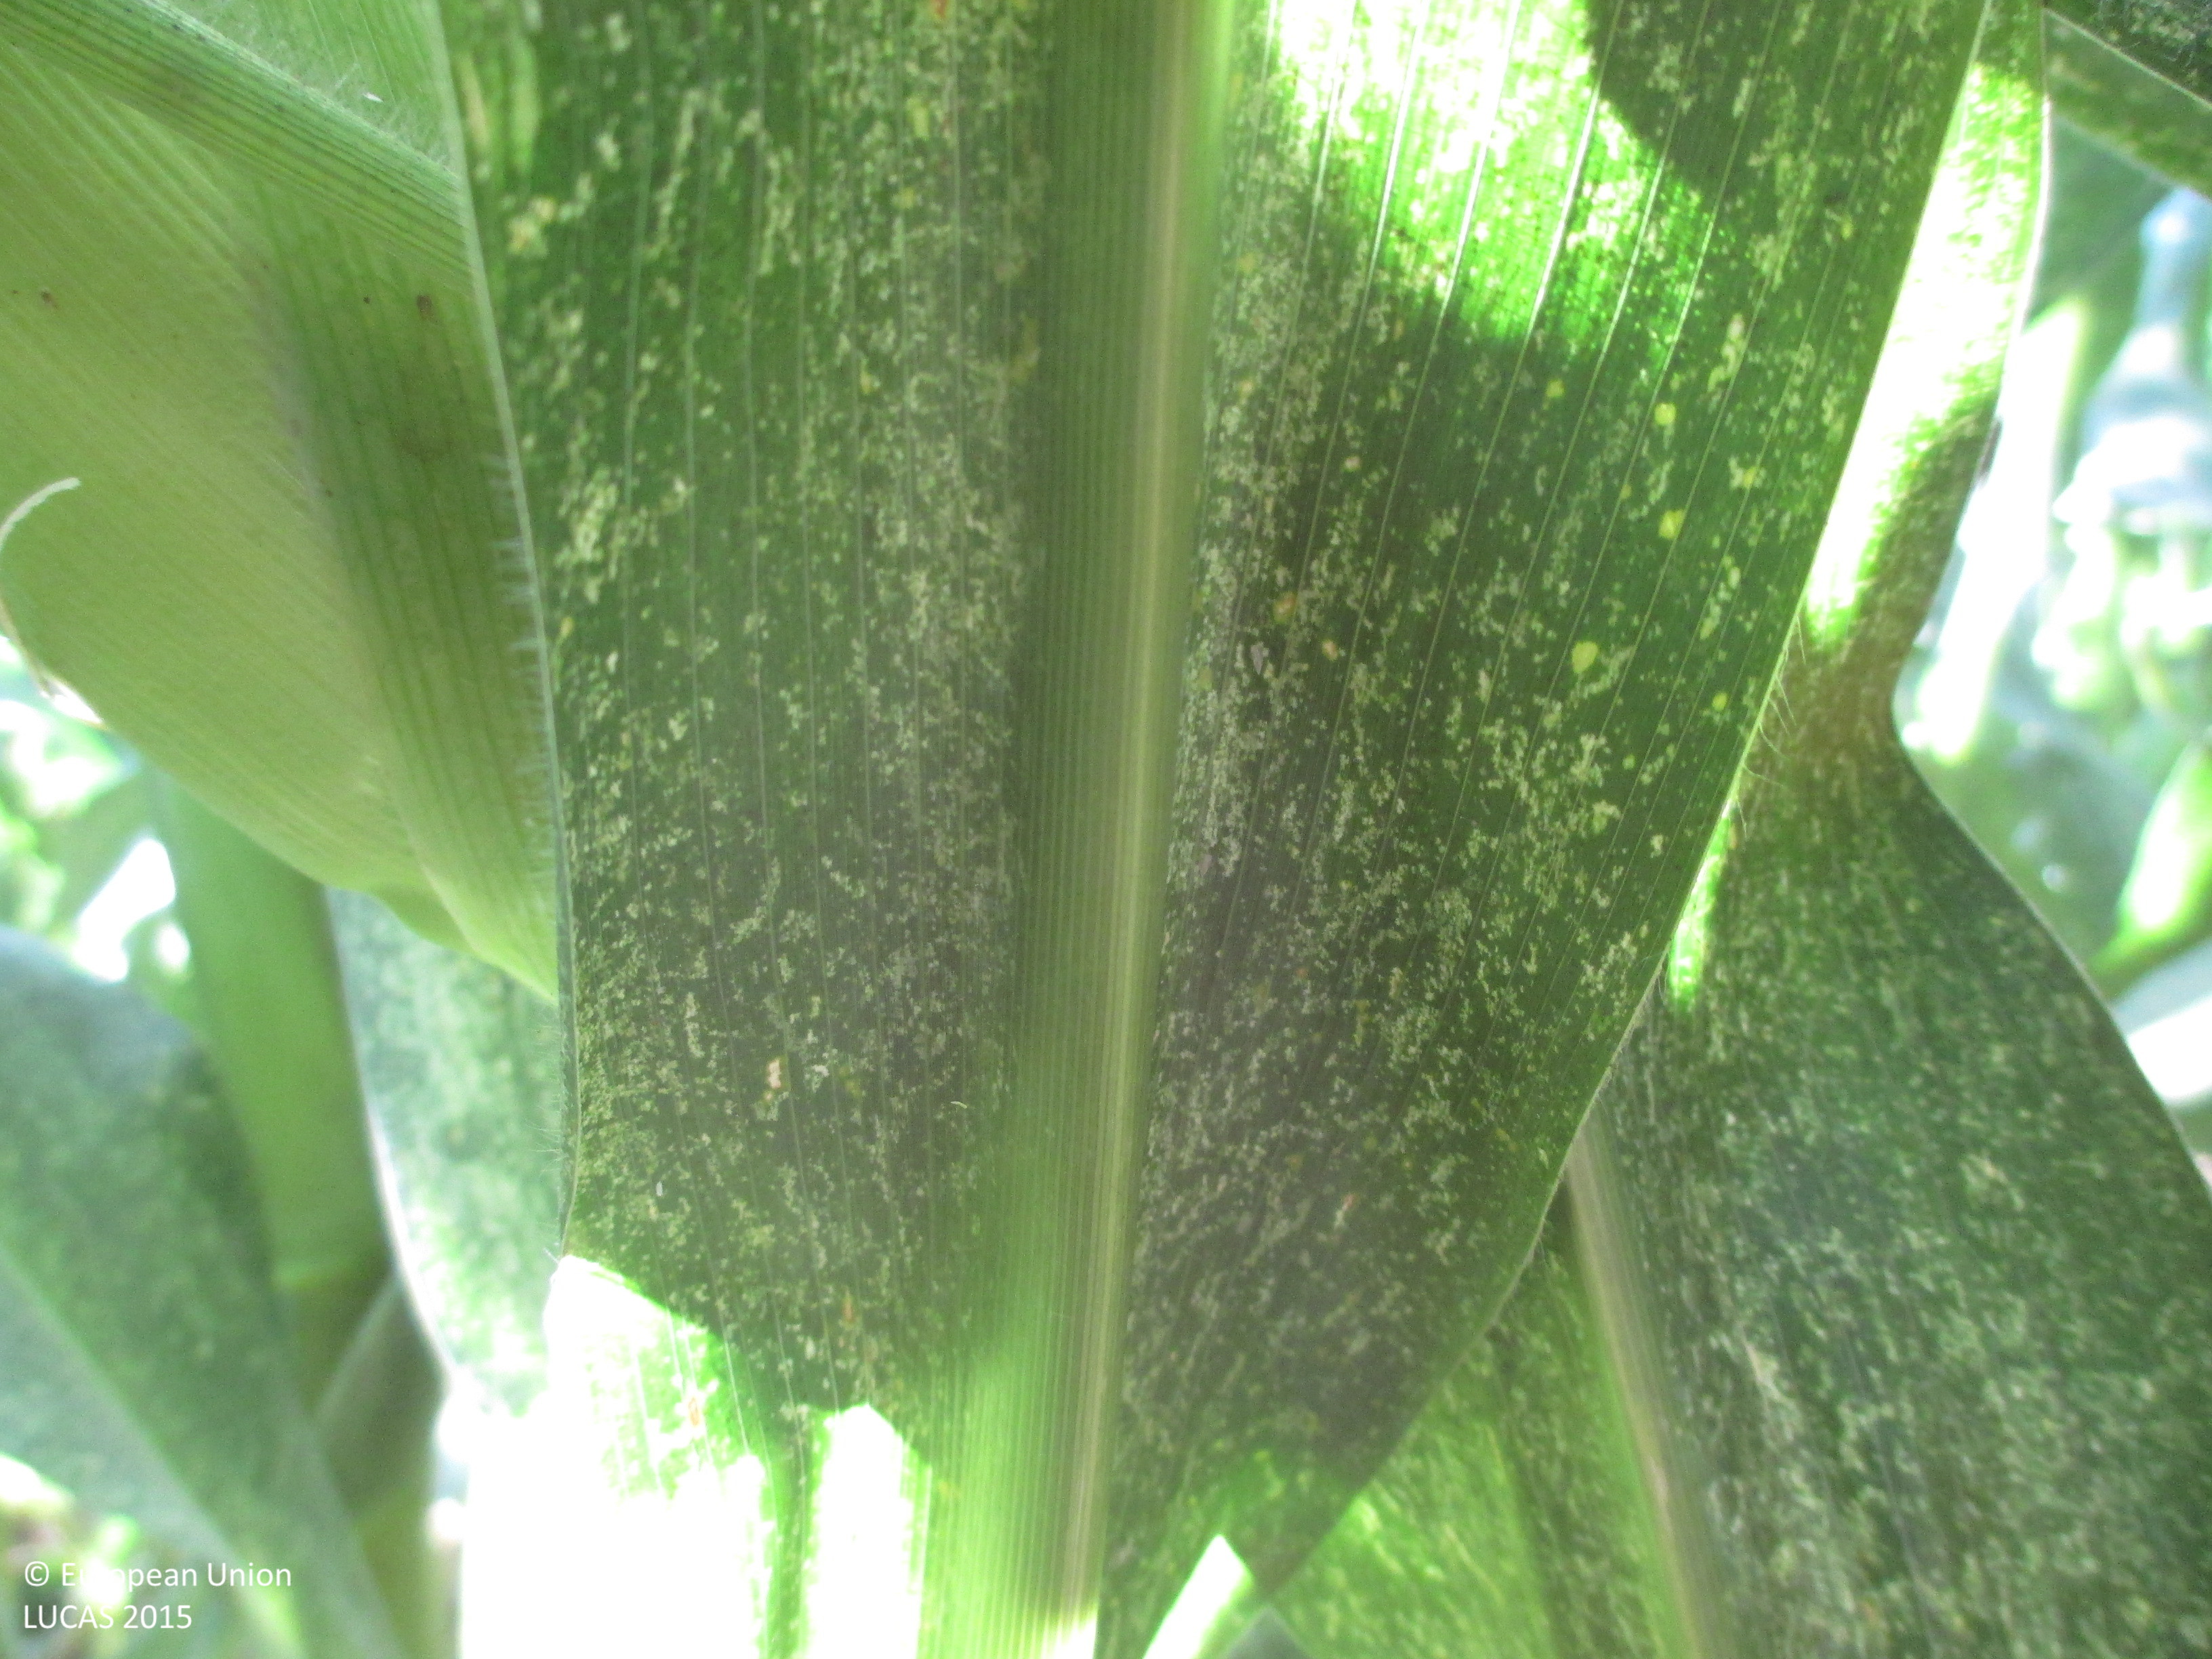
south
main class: Cropland
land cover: Maize
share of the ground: > 75 %
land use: Agriculture (excluding fallow land and kitchen gardens)
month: July
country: ES
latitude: 42.0130
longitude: 0.1893
